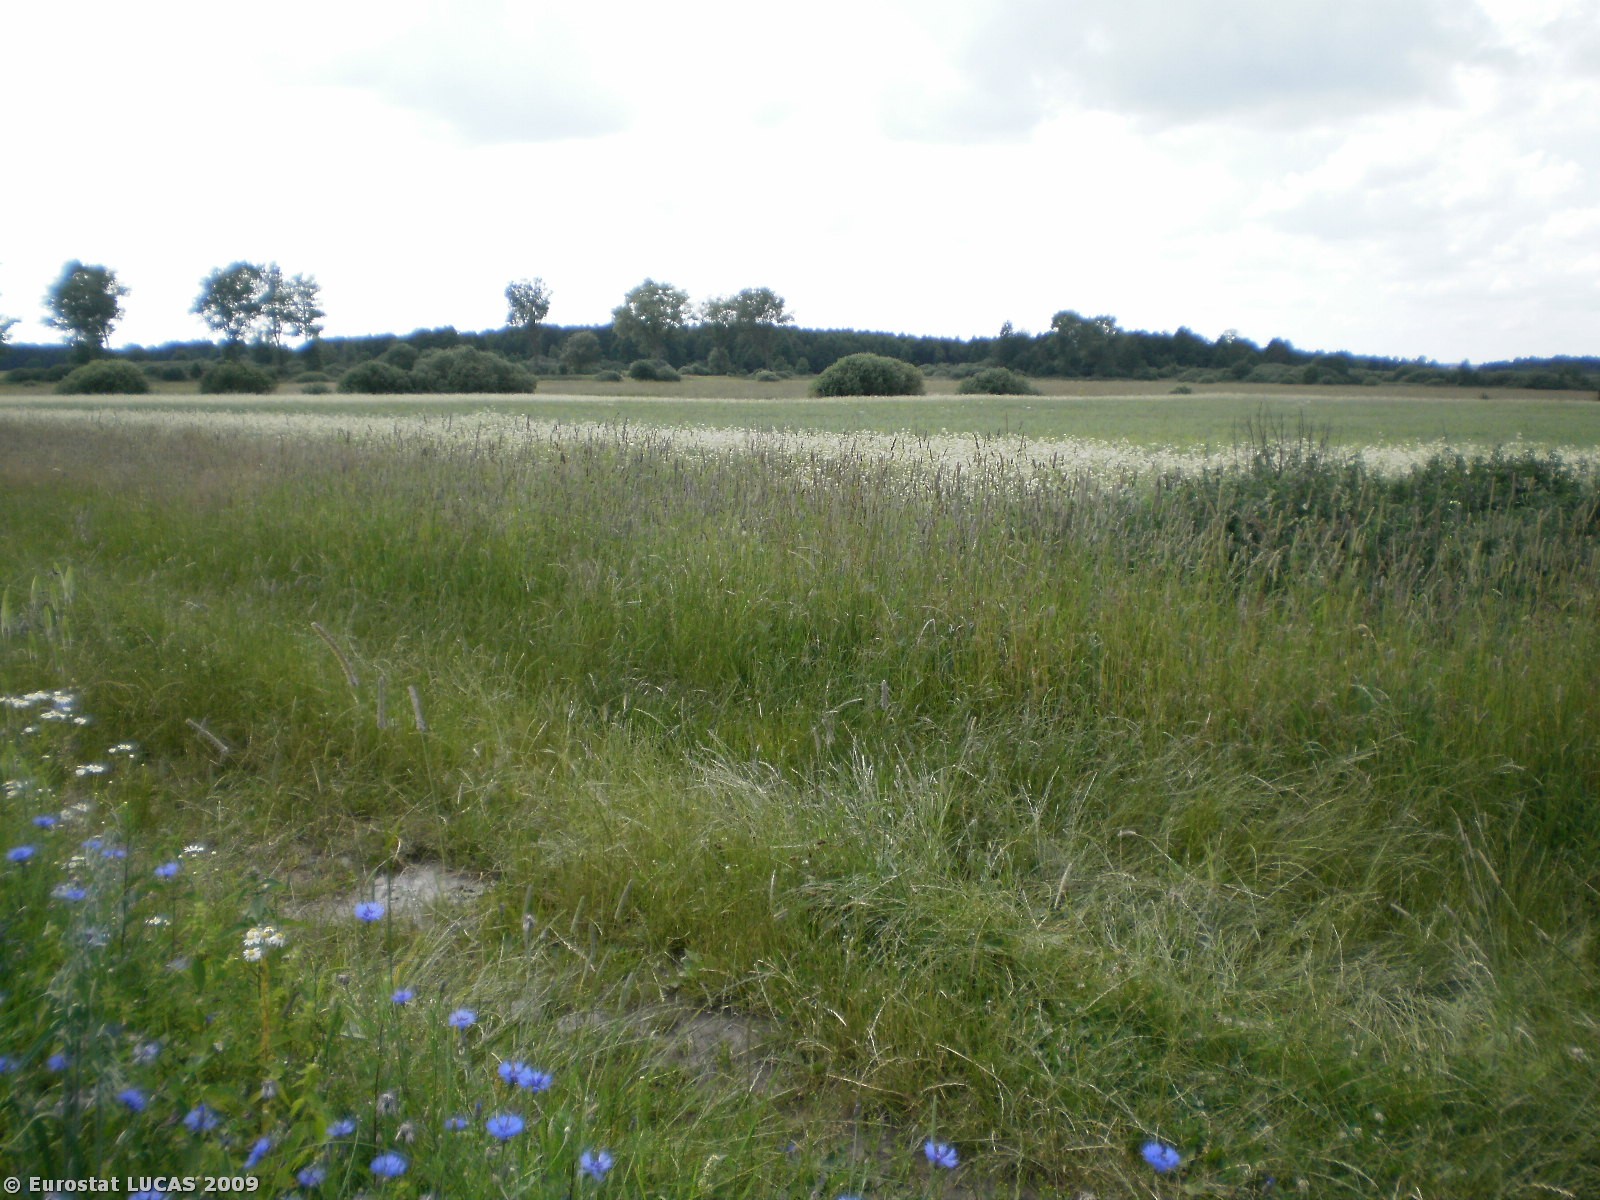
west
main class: Cropland
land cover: Oats
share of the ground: > 75 %
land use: Agriculture (excluding fallow land and kitchen gardens)
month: July
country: PL
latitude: 53.2641
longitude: 20.3656
